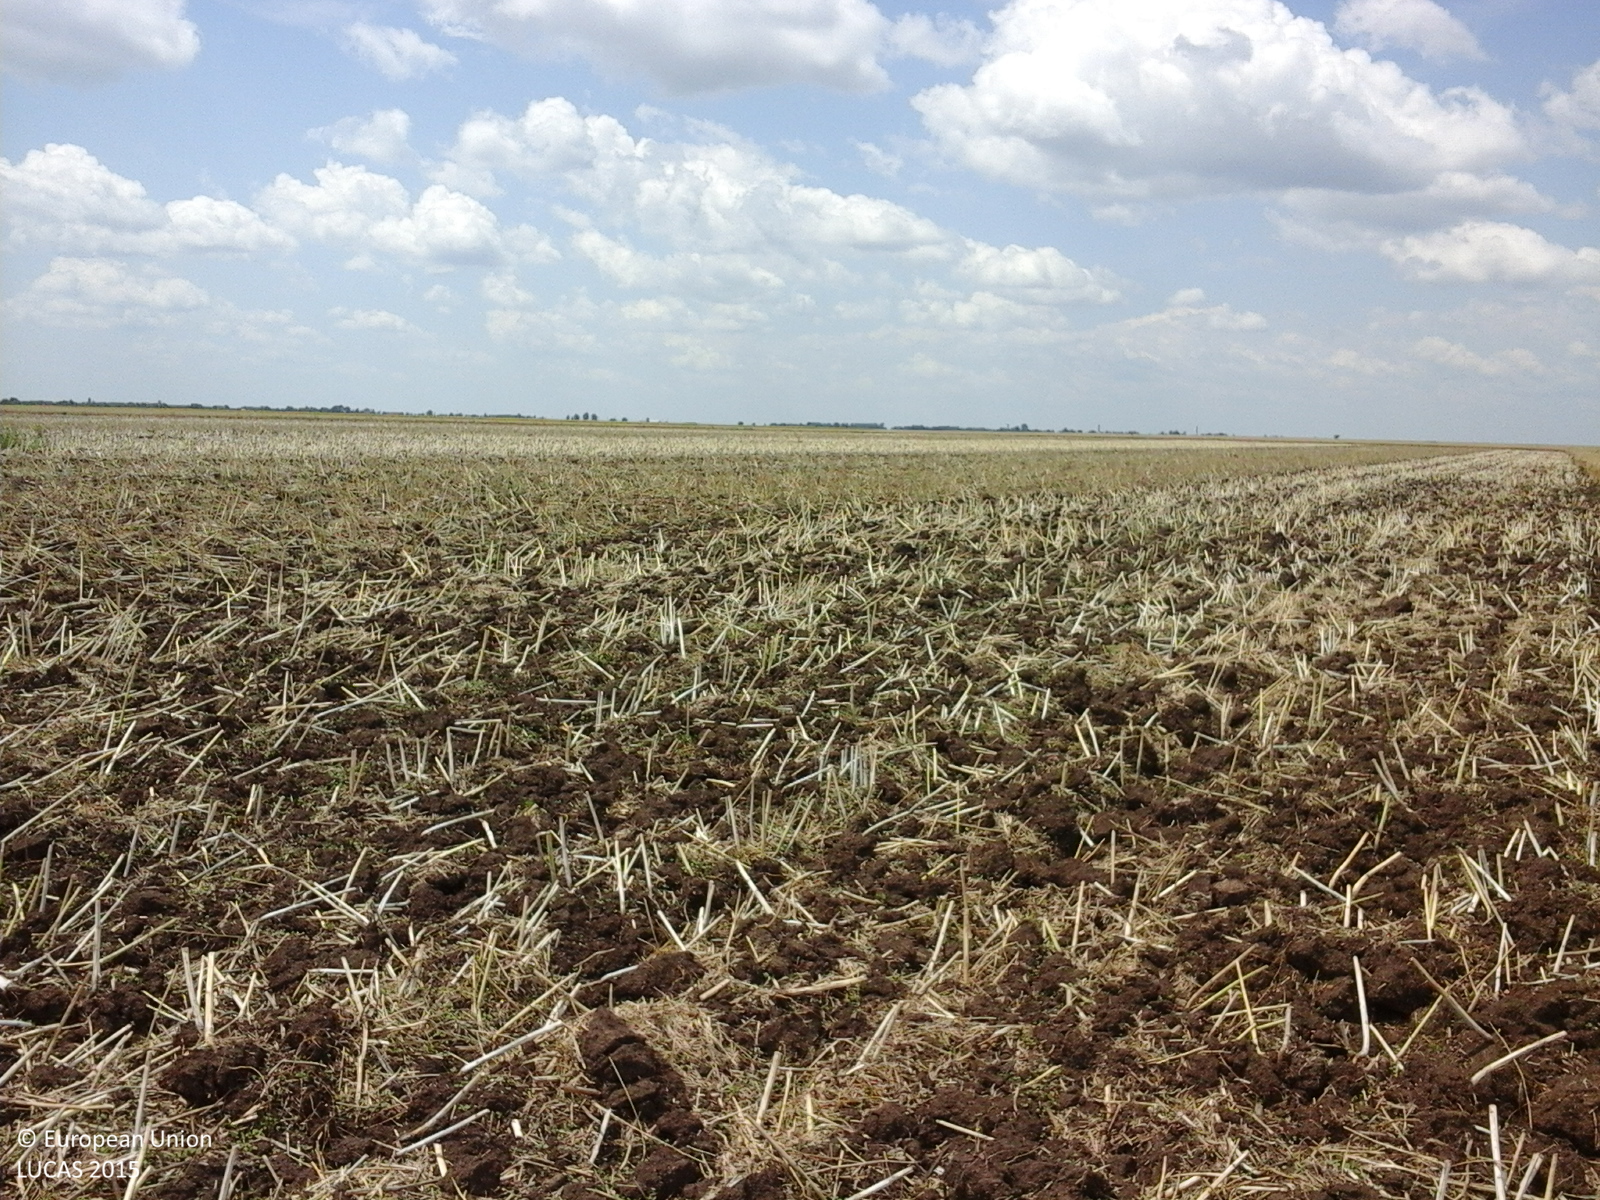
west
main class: Cropland
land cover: Common wheat
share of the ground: > 75 %
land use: Agriculture (excluding fallow land and kitchen gardens)
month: July
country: RO
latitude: 43.8937
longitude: 24.3665
